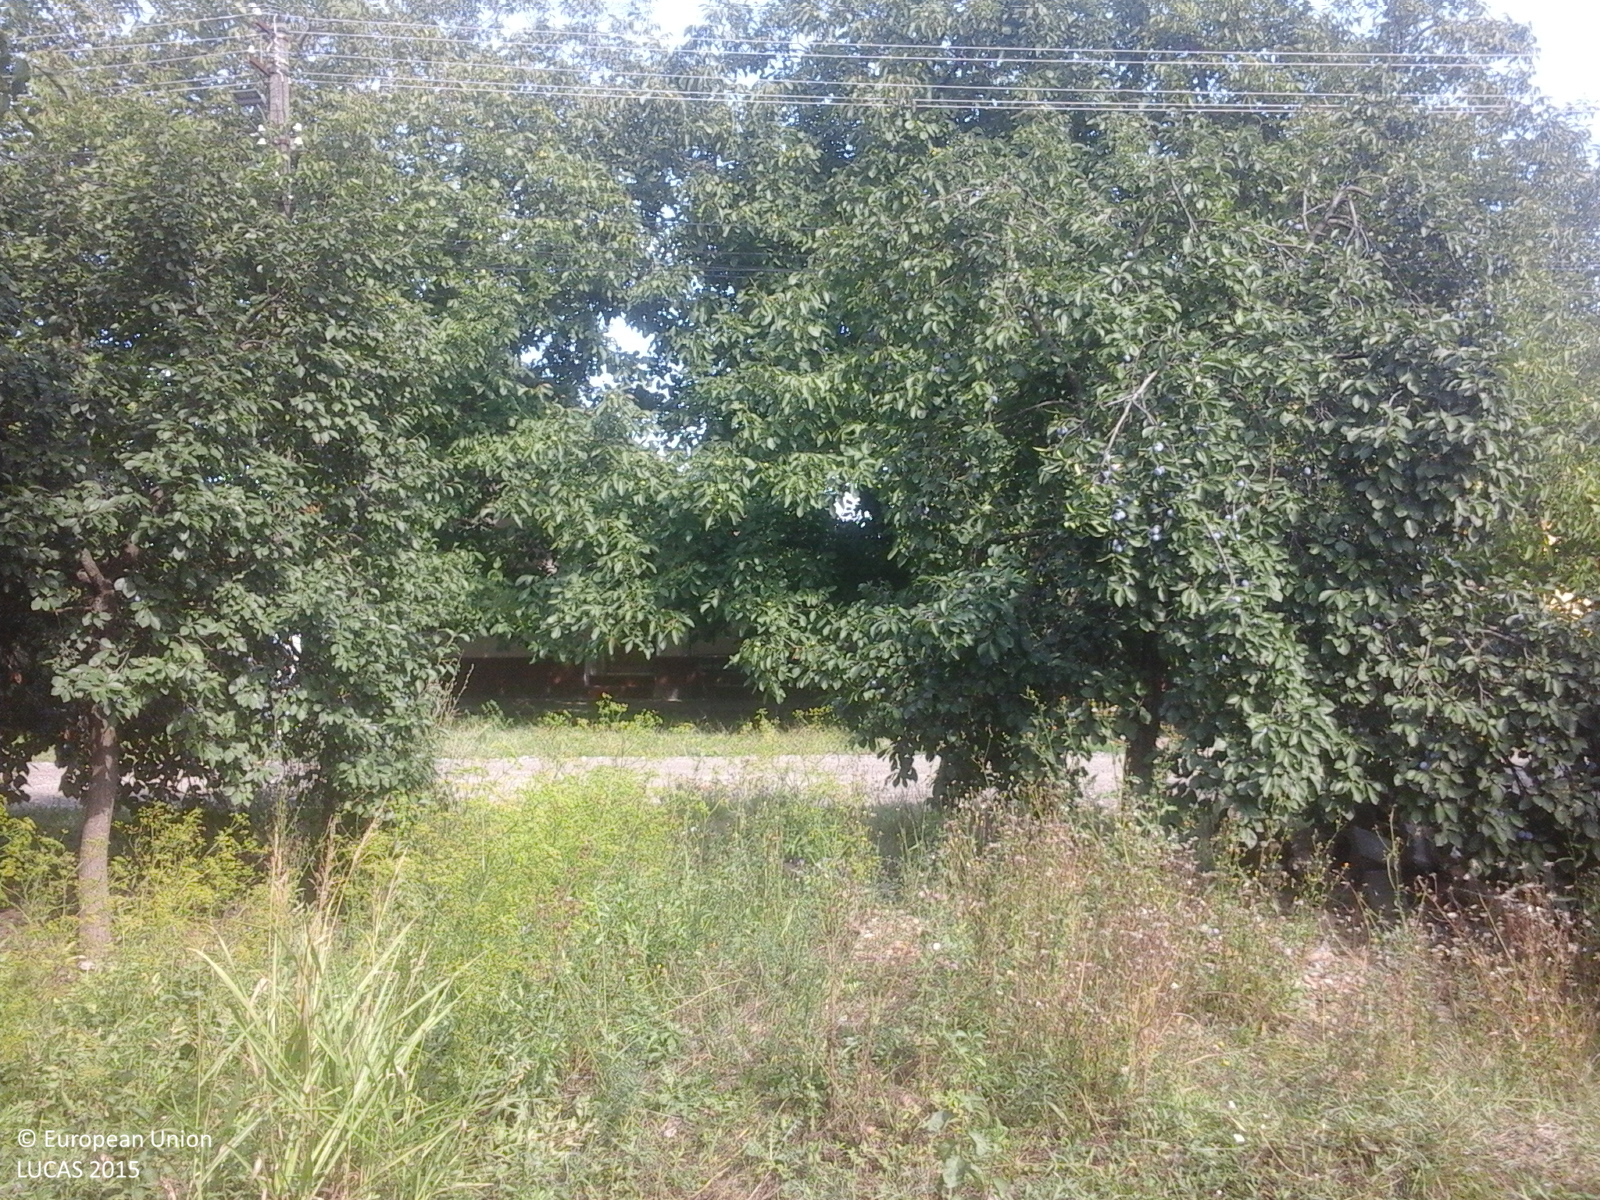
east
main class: Cropland
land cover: Vineyards
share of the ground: > 75 %
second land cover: Other bare soil
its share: > 75 %
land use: Kitchen garden
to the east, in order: Vineyards; Other bare soil; Artificial constructions in urban areas; Permanent crops (only in case pi); Artificial constructions in urban areas
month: August
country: RO
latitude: 45.7617
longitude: 21.0213
